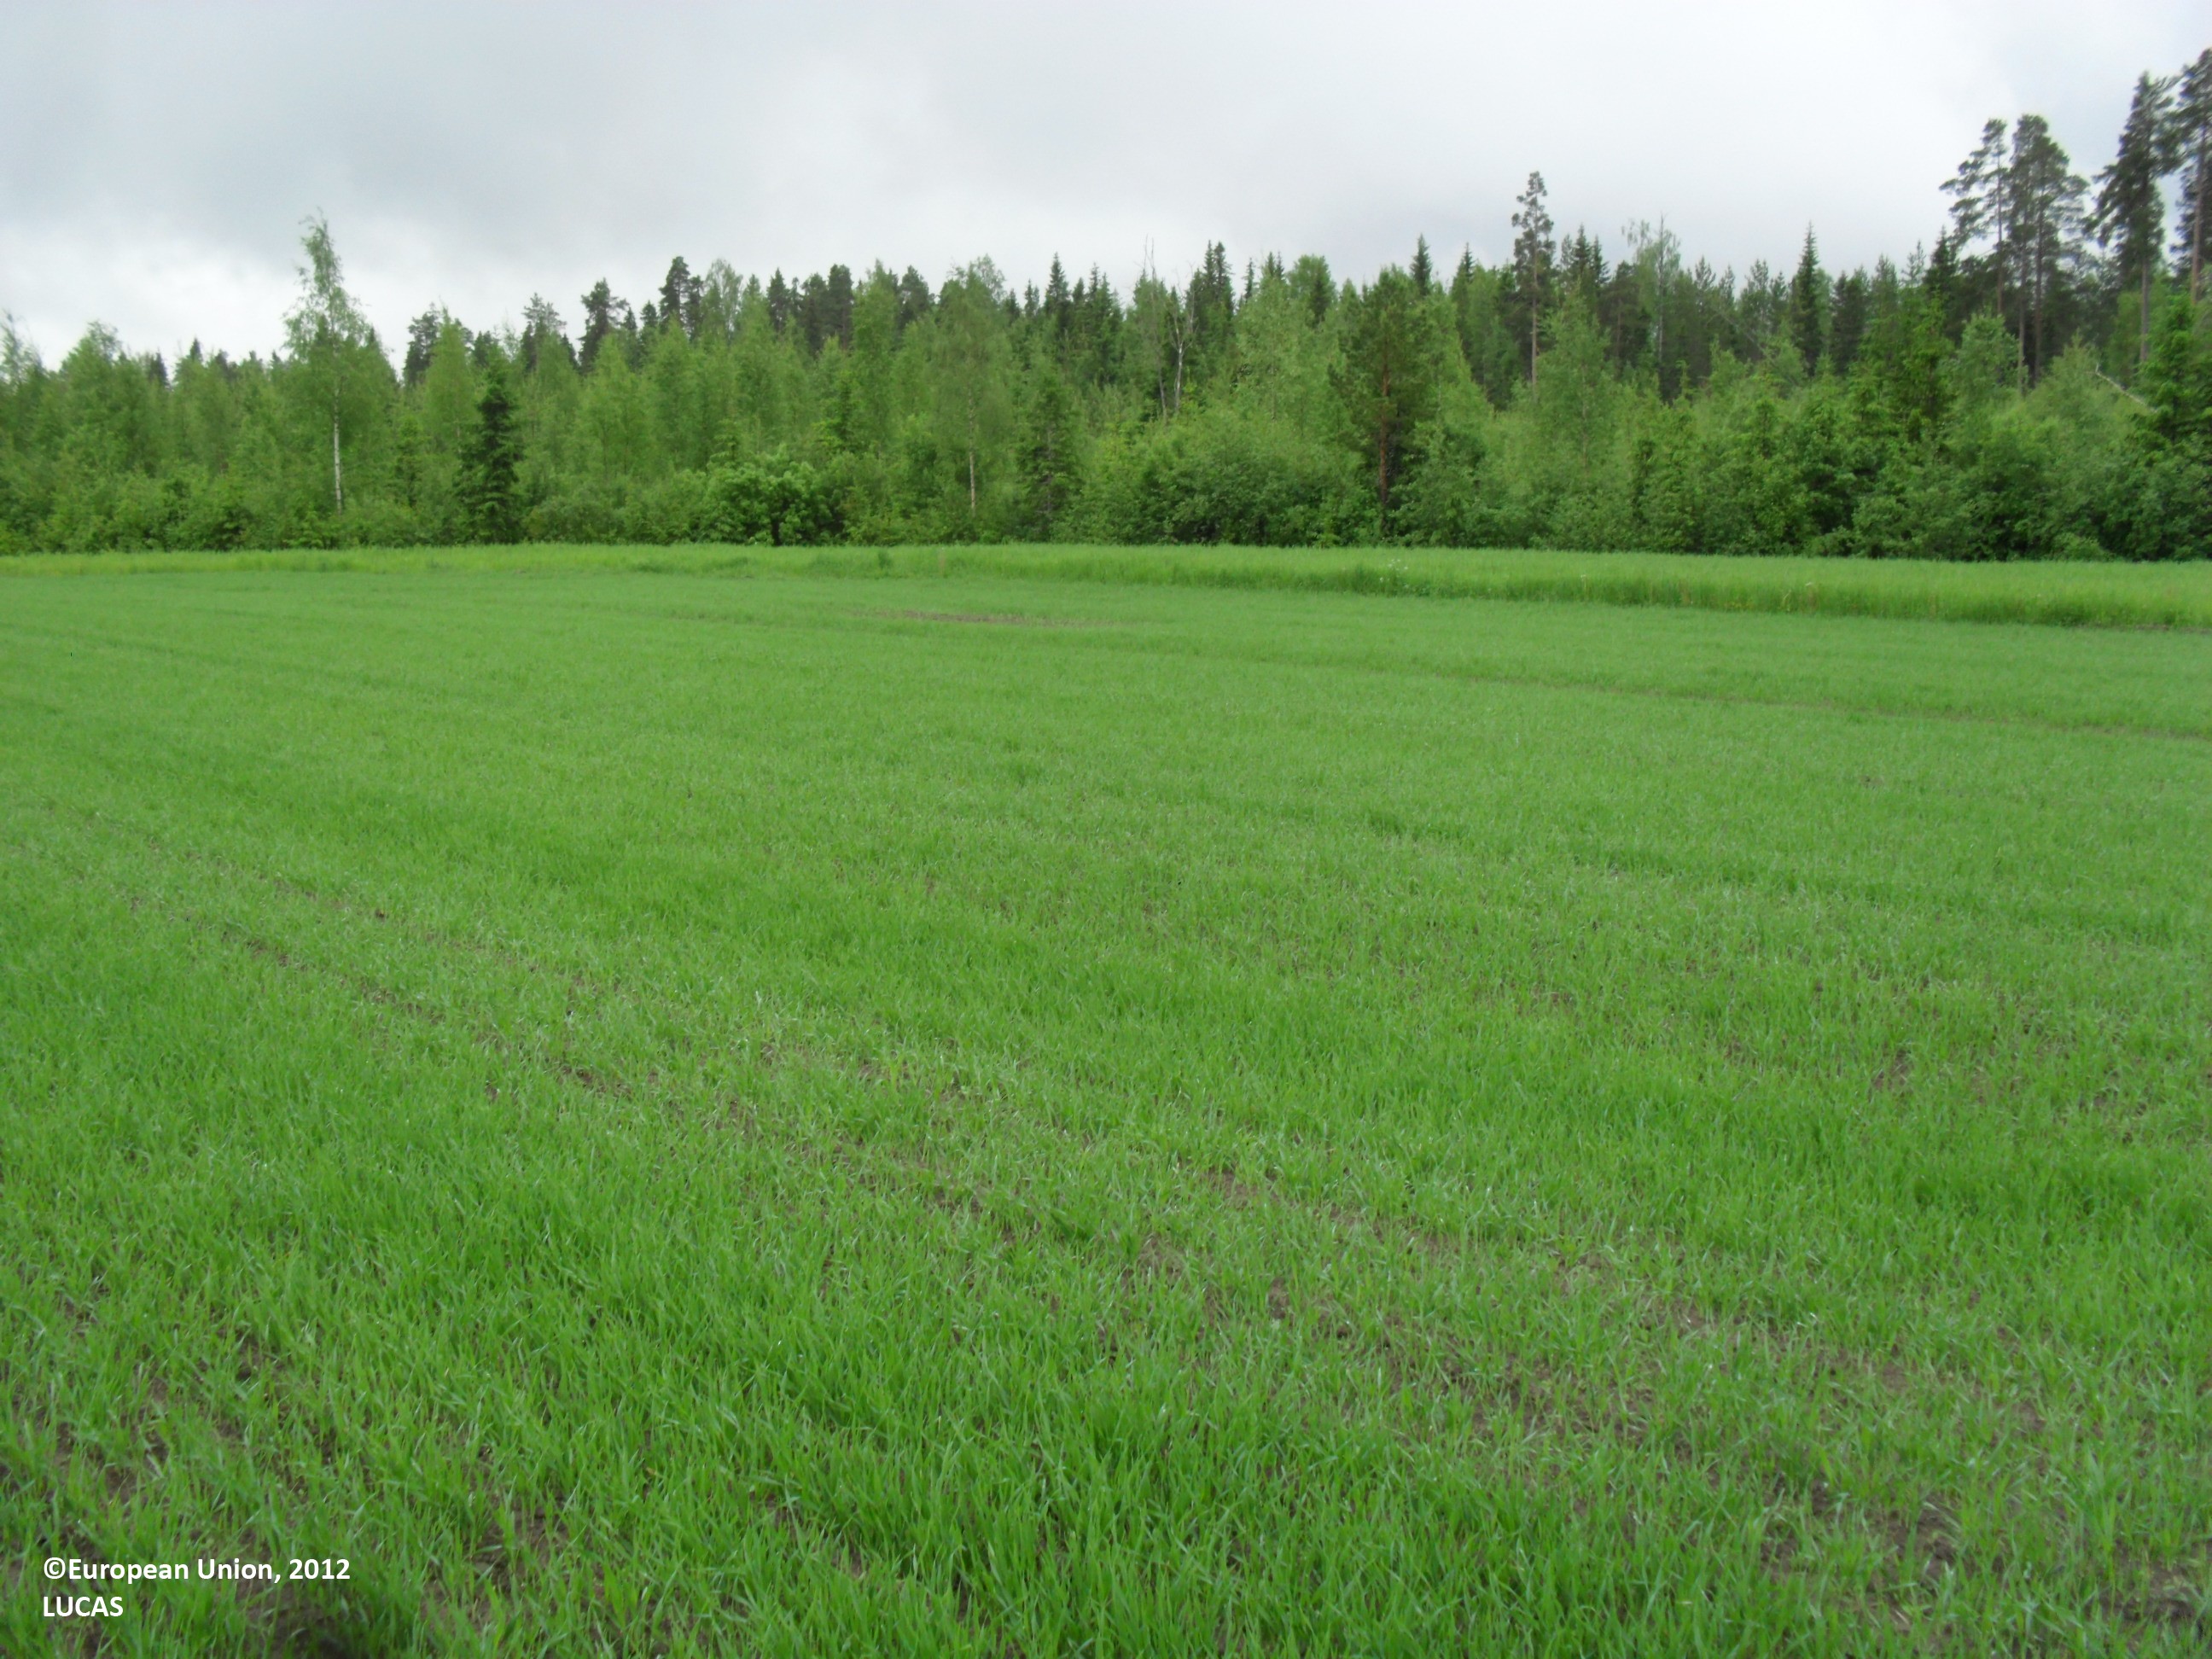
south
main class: Cropland
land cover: Barley
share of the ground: 50 - 75 %
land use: Agriculture (excluding fallow land and kitchen gardens)
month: June
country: FI
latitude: 63.0745
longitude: 23.1843
